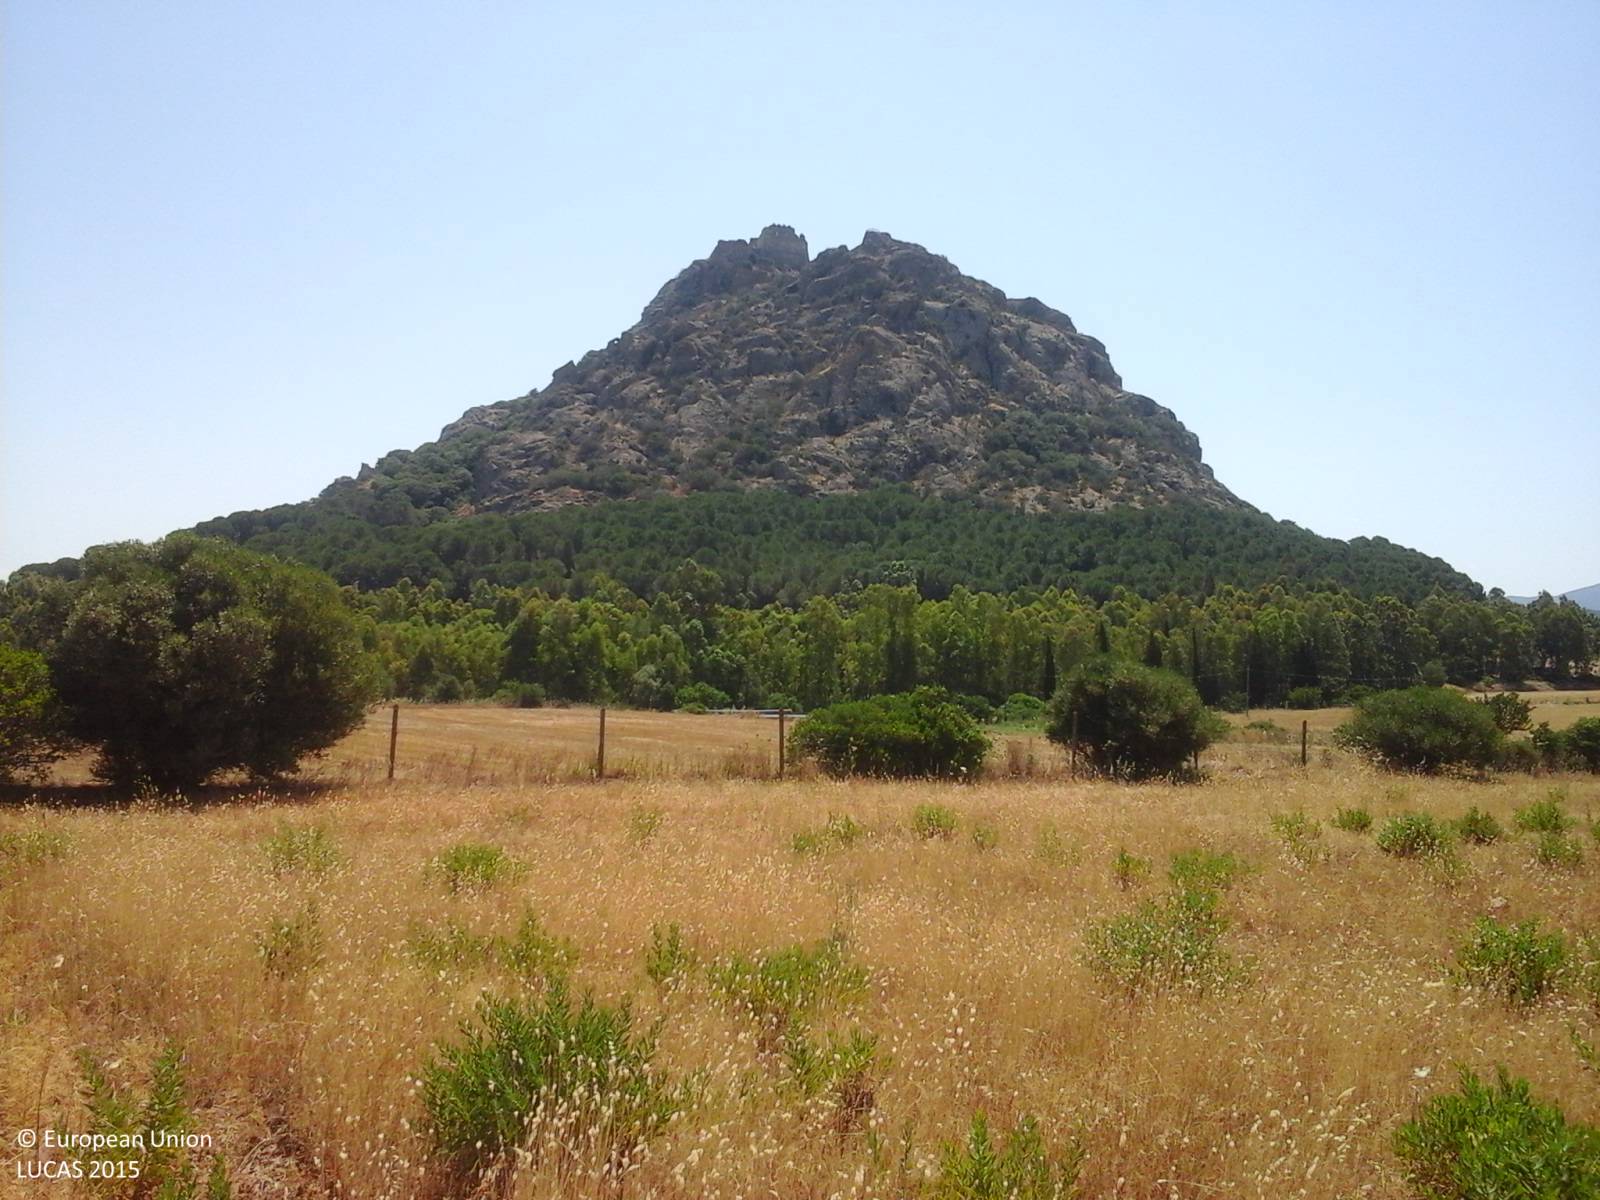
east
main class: Grassland
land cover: Spontaneously vegetated surfaces
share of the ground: > 75 %
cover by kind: herbaceous plants 85 %, unconsolidated bare surface 15 %
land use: Agriculture (excluding fallow land and kitchen gardens)
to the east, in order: Spontaneously vegetated surfaces; Fences; Abandoned hedges; Durum wheat; Single bushes/trees; Durum wheat; Fences; Abandoned hedges; Paved roads, cycling and walking lanes; Abandoned hedges; Mixed cereals for fodder; Broadleaved woodland; Shrubland without tree cover
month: June
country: IT
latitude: 39.2639
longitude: 8.8136
